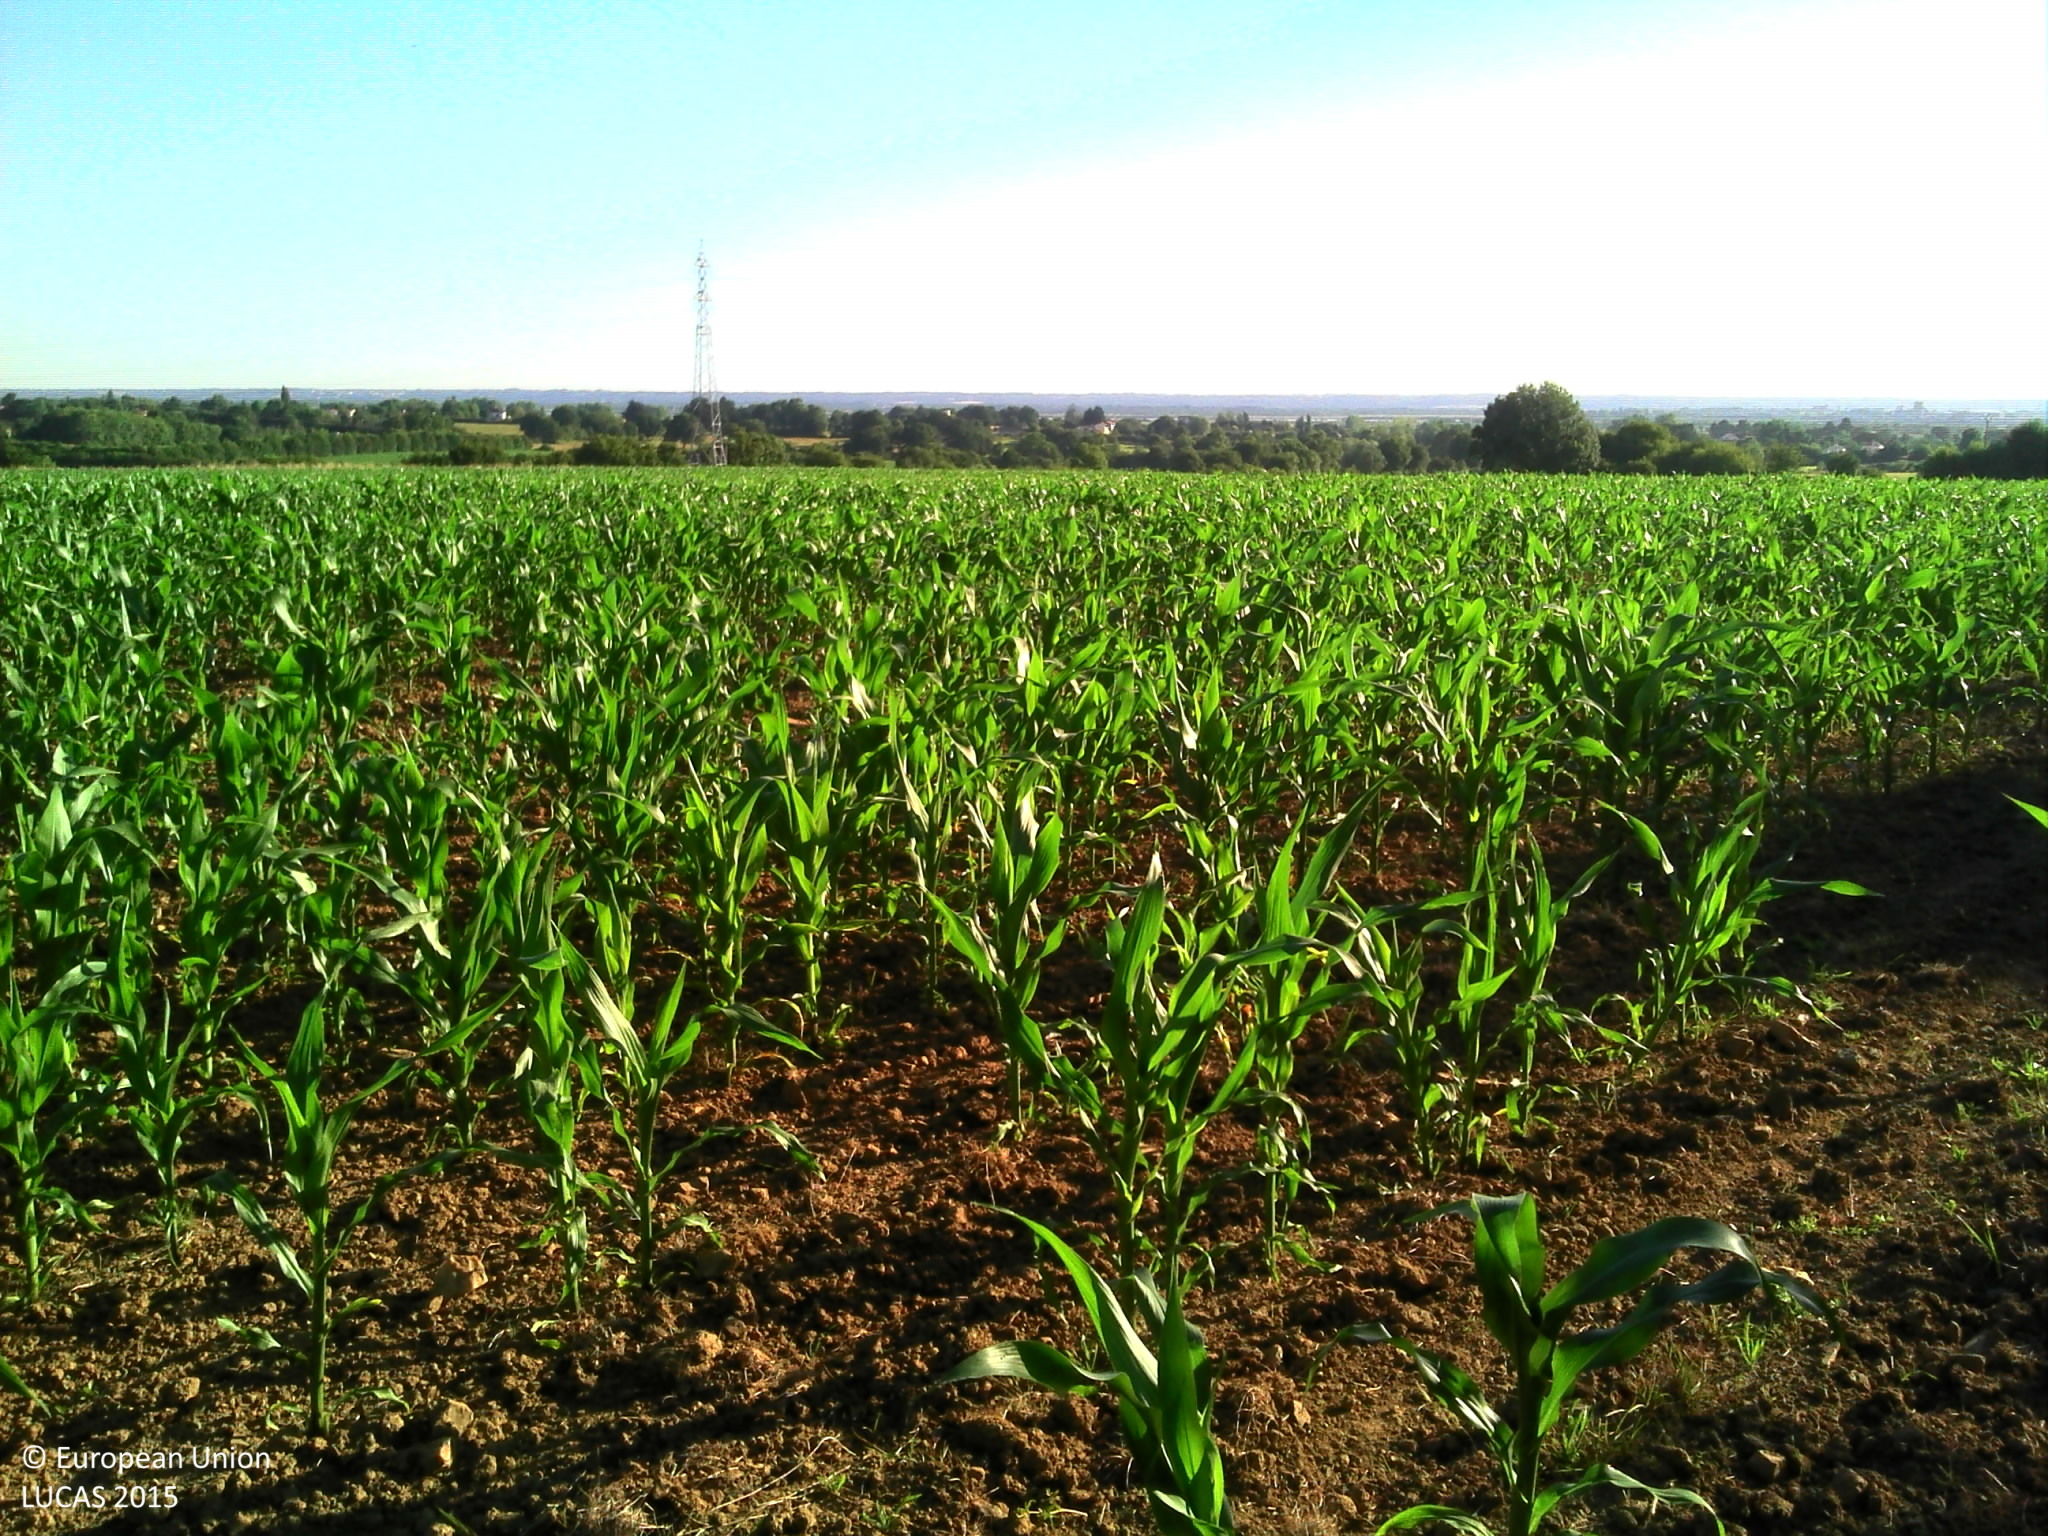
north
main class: Cropland
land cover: Maize
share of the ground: 25 - 50 %
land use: Agriculture (excluding fallow land and kitchen gardens)
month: June
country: FR
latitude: 47.2462
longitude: -1.9247
